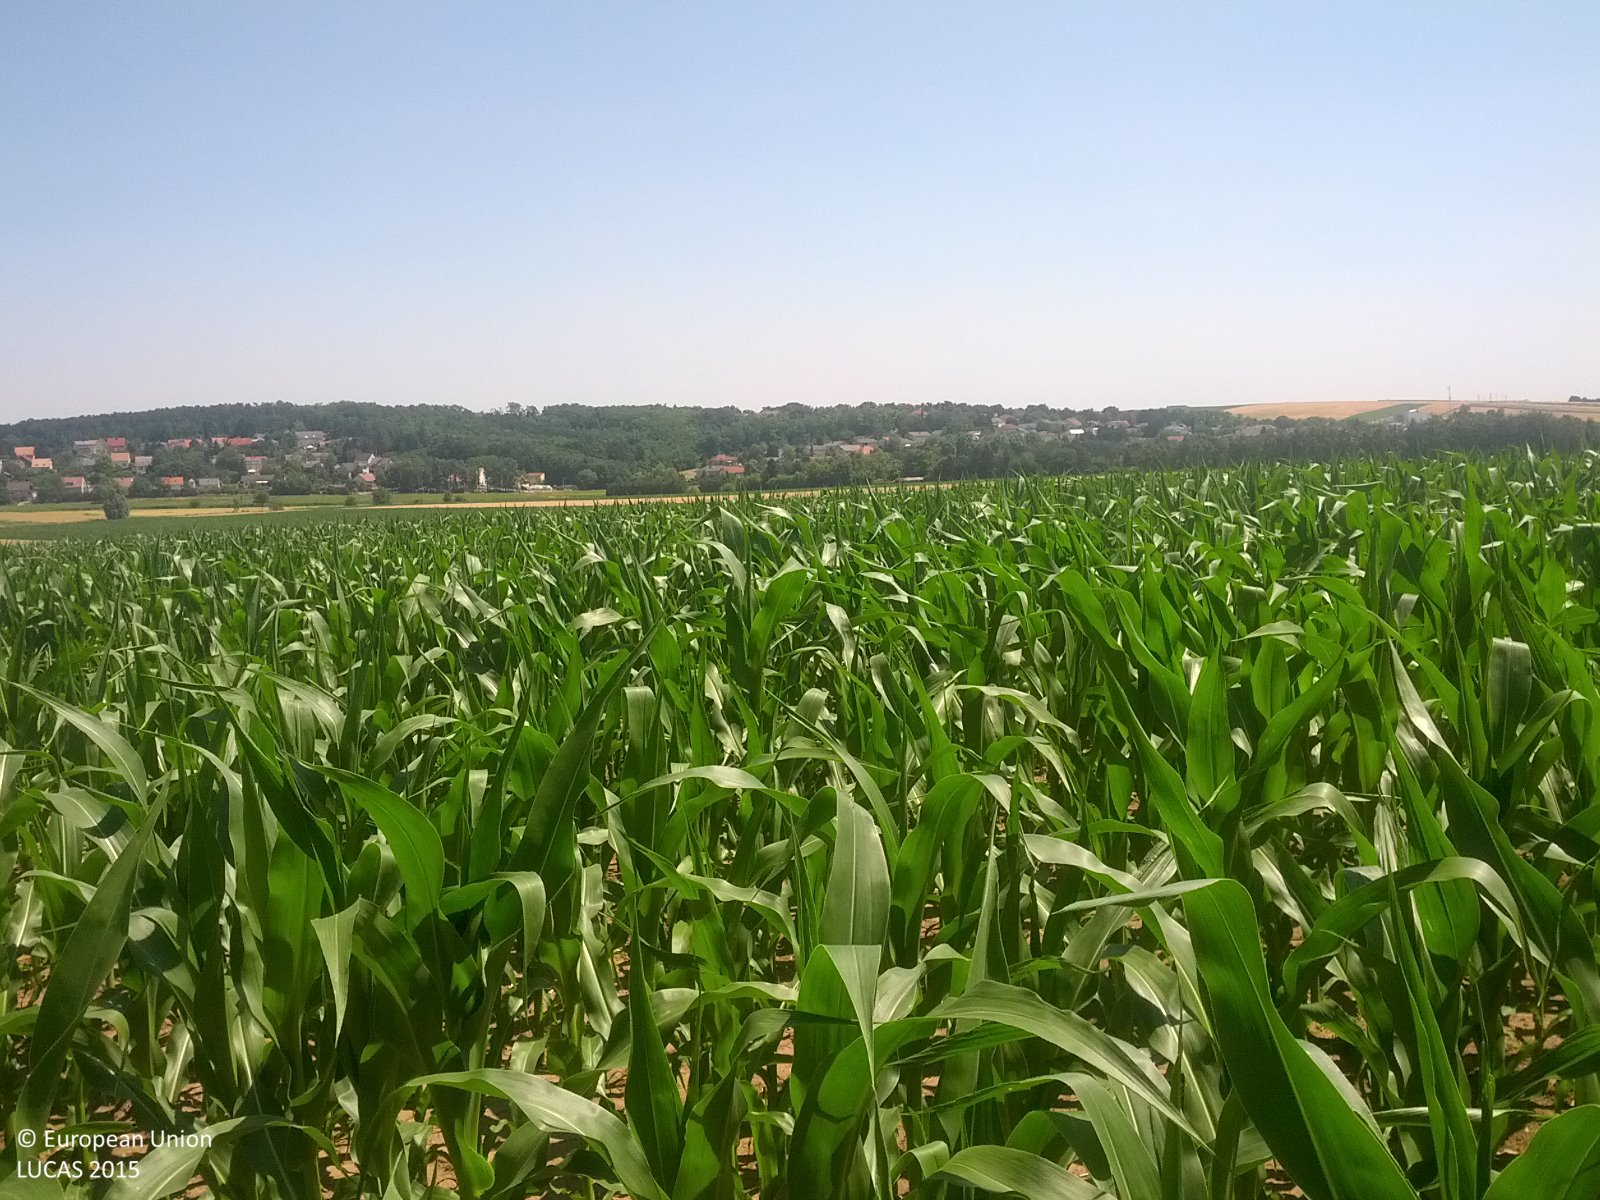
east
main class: Cropland
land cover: Maize
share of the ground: > 75 %
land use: Agriculture (excluding fallow land and kitchen gardens)
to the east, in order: Maize; Common wheat; Maize; Common wheat; Grass margins; Tracks; Grass margins; Maize
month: July
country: AT
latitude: 48.5880
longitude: 16.5545
